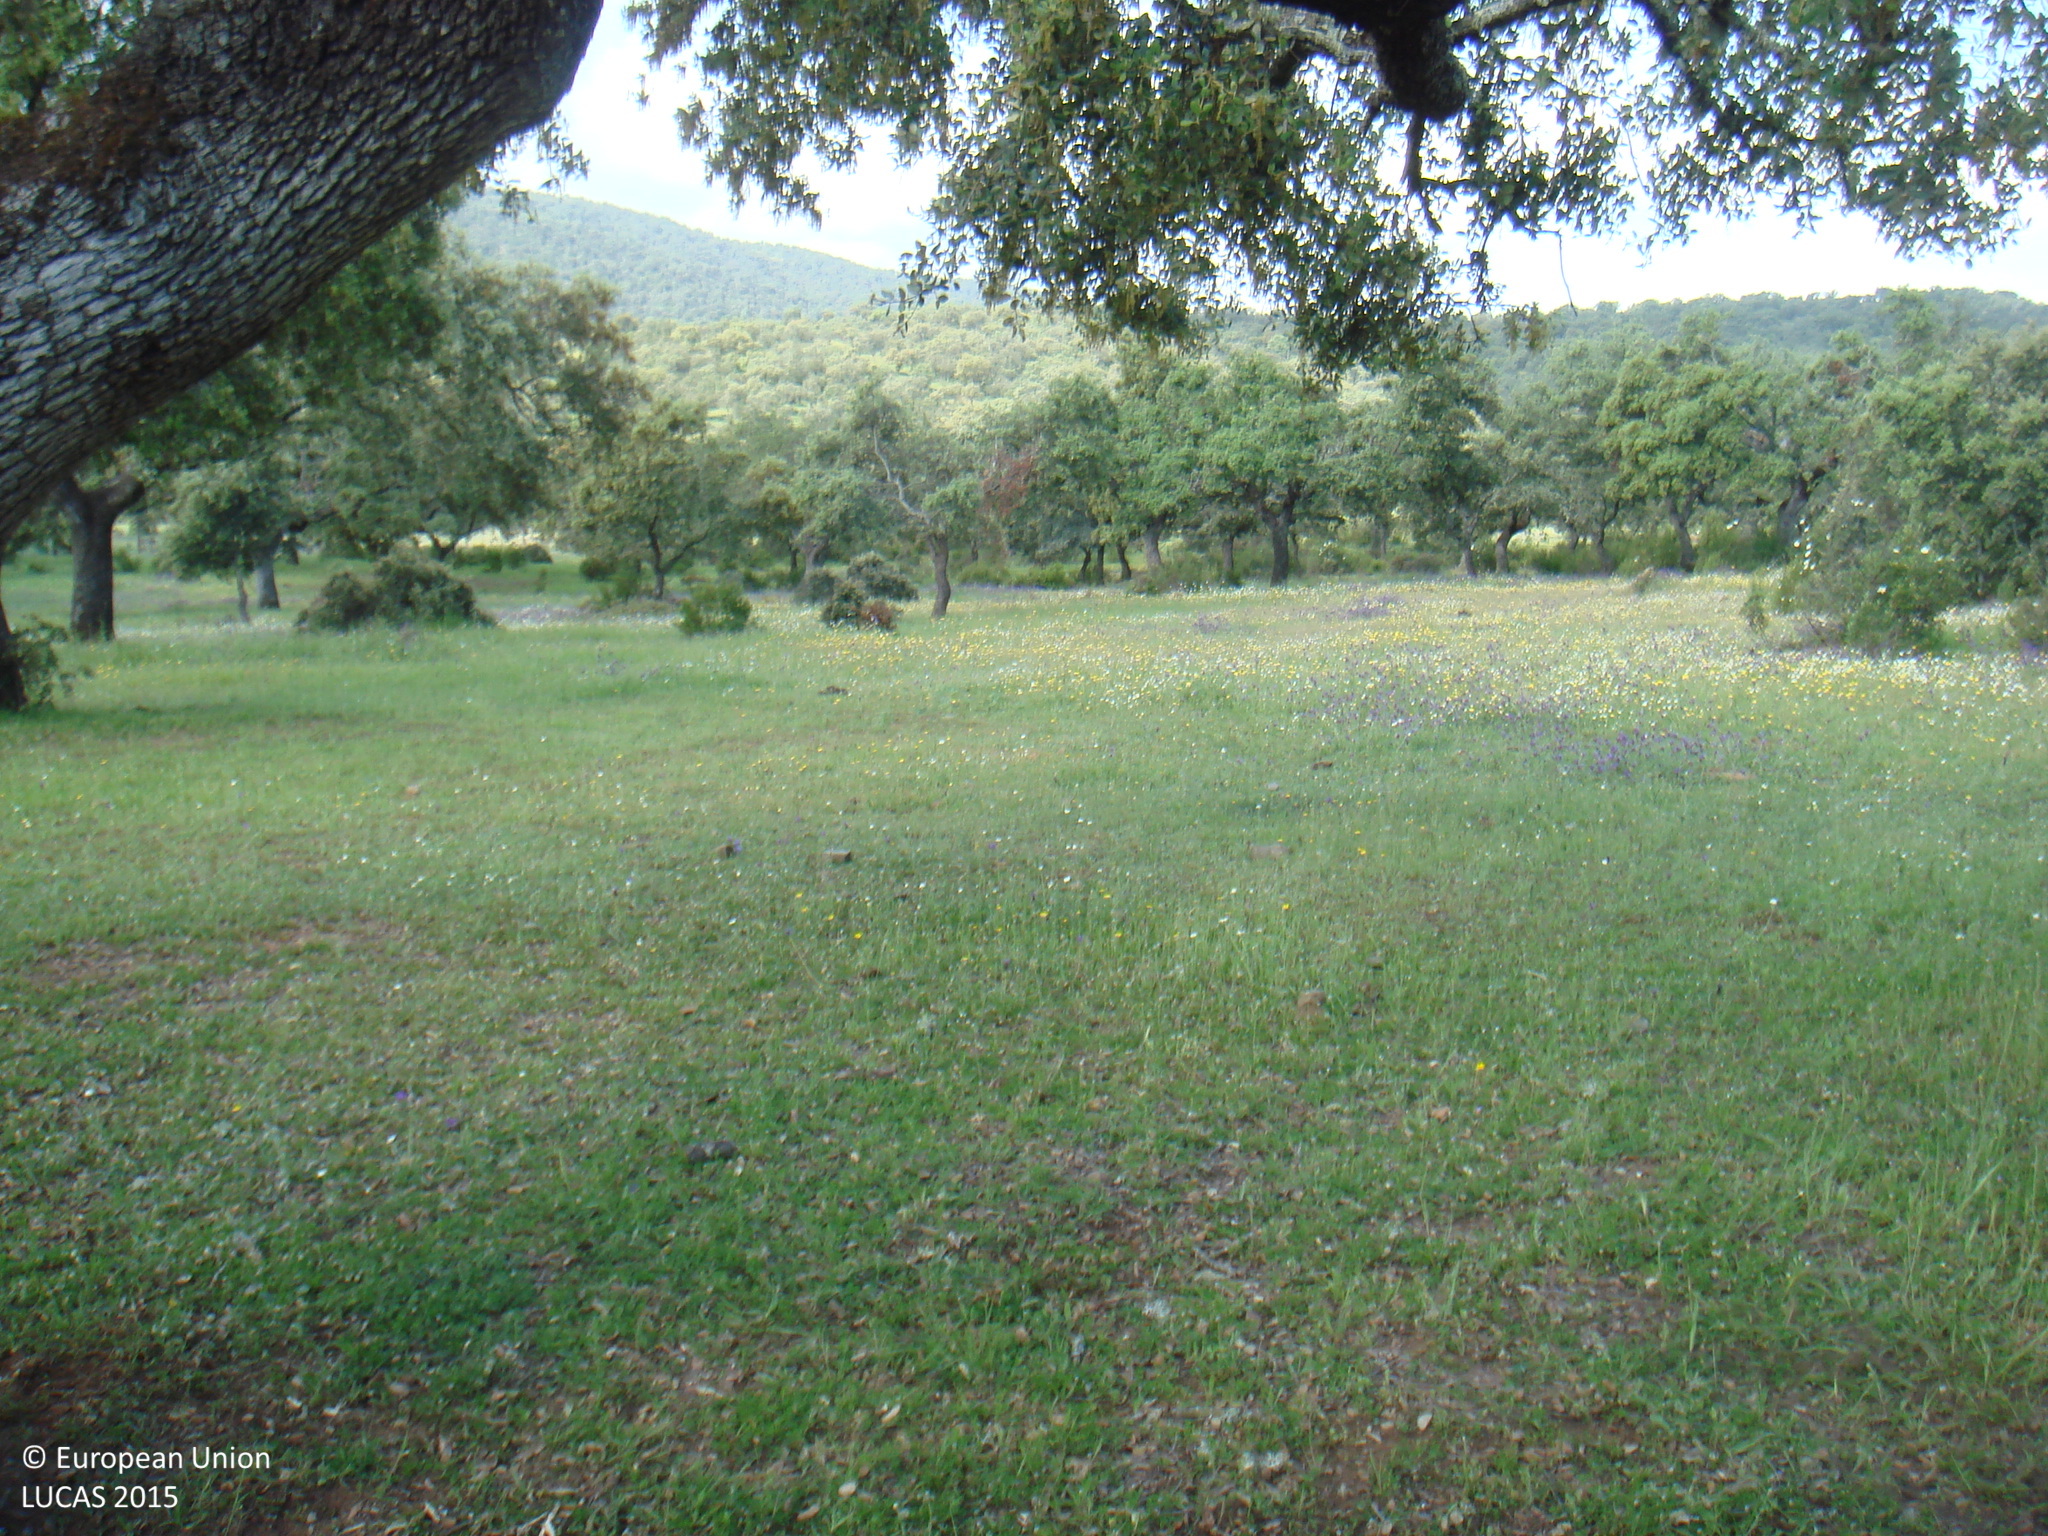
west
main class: Woodland
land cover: Broadleaved woodland
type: broadleaved evergreen forest
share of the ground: 25 - 50 %
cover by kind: herbaceous plants 60 %, broadleaved forest trees 30 %, shrubs 10 %
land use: Forestry
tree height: > 5 m
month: April
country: ES
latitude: 38.1929
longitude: -5.0842
